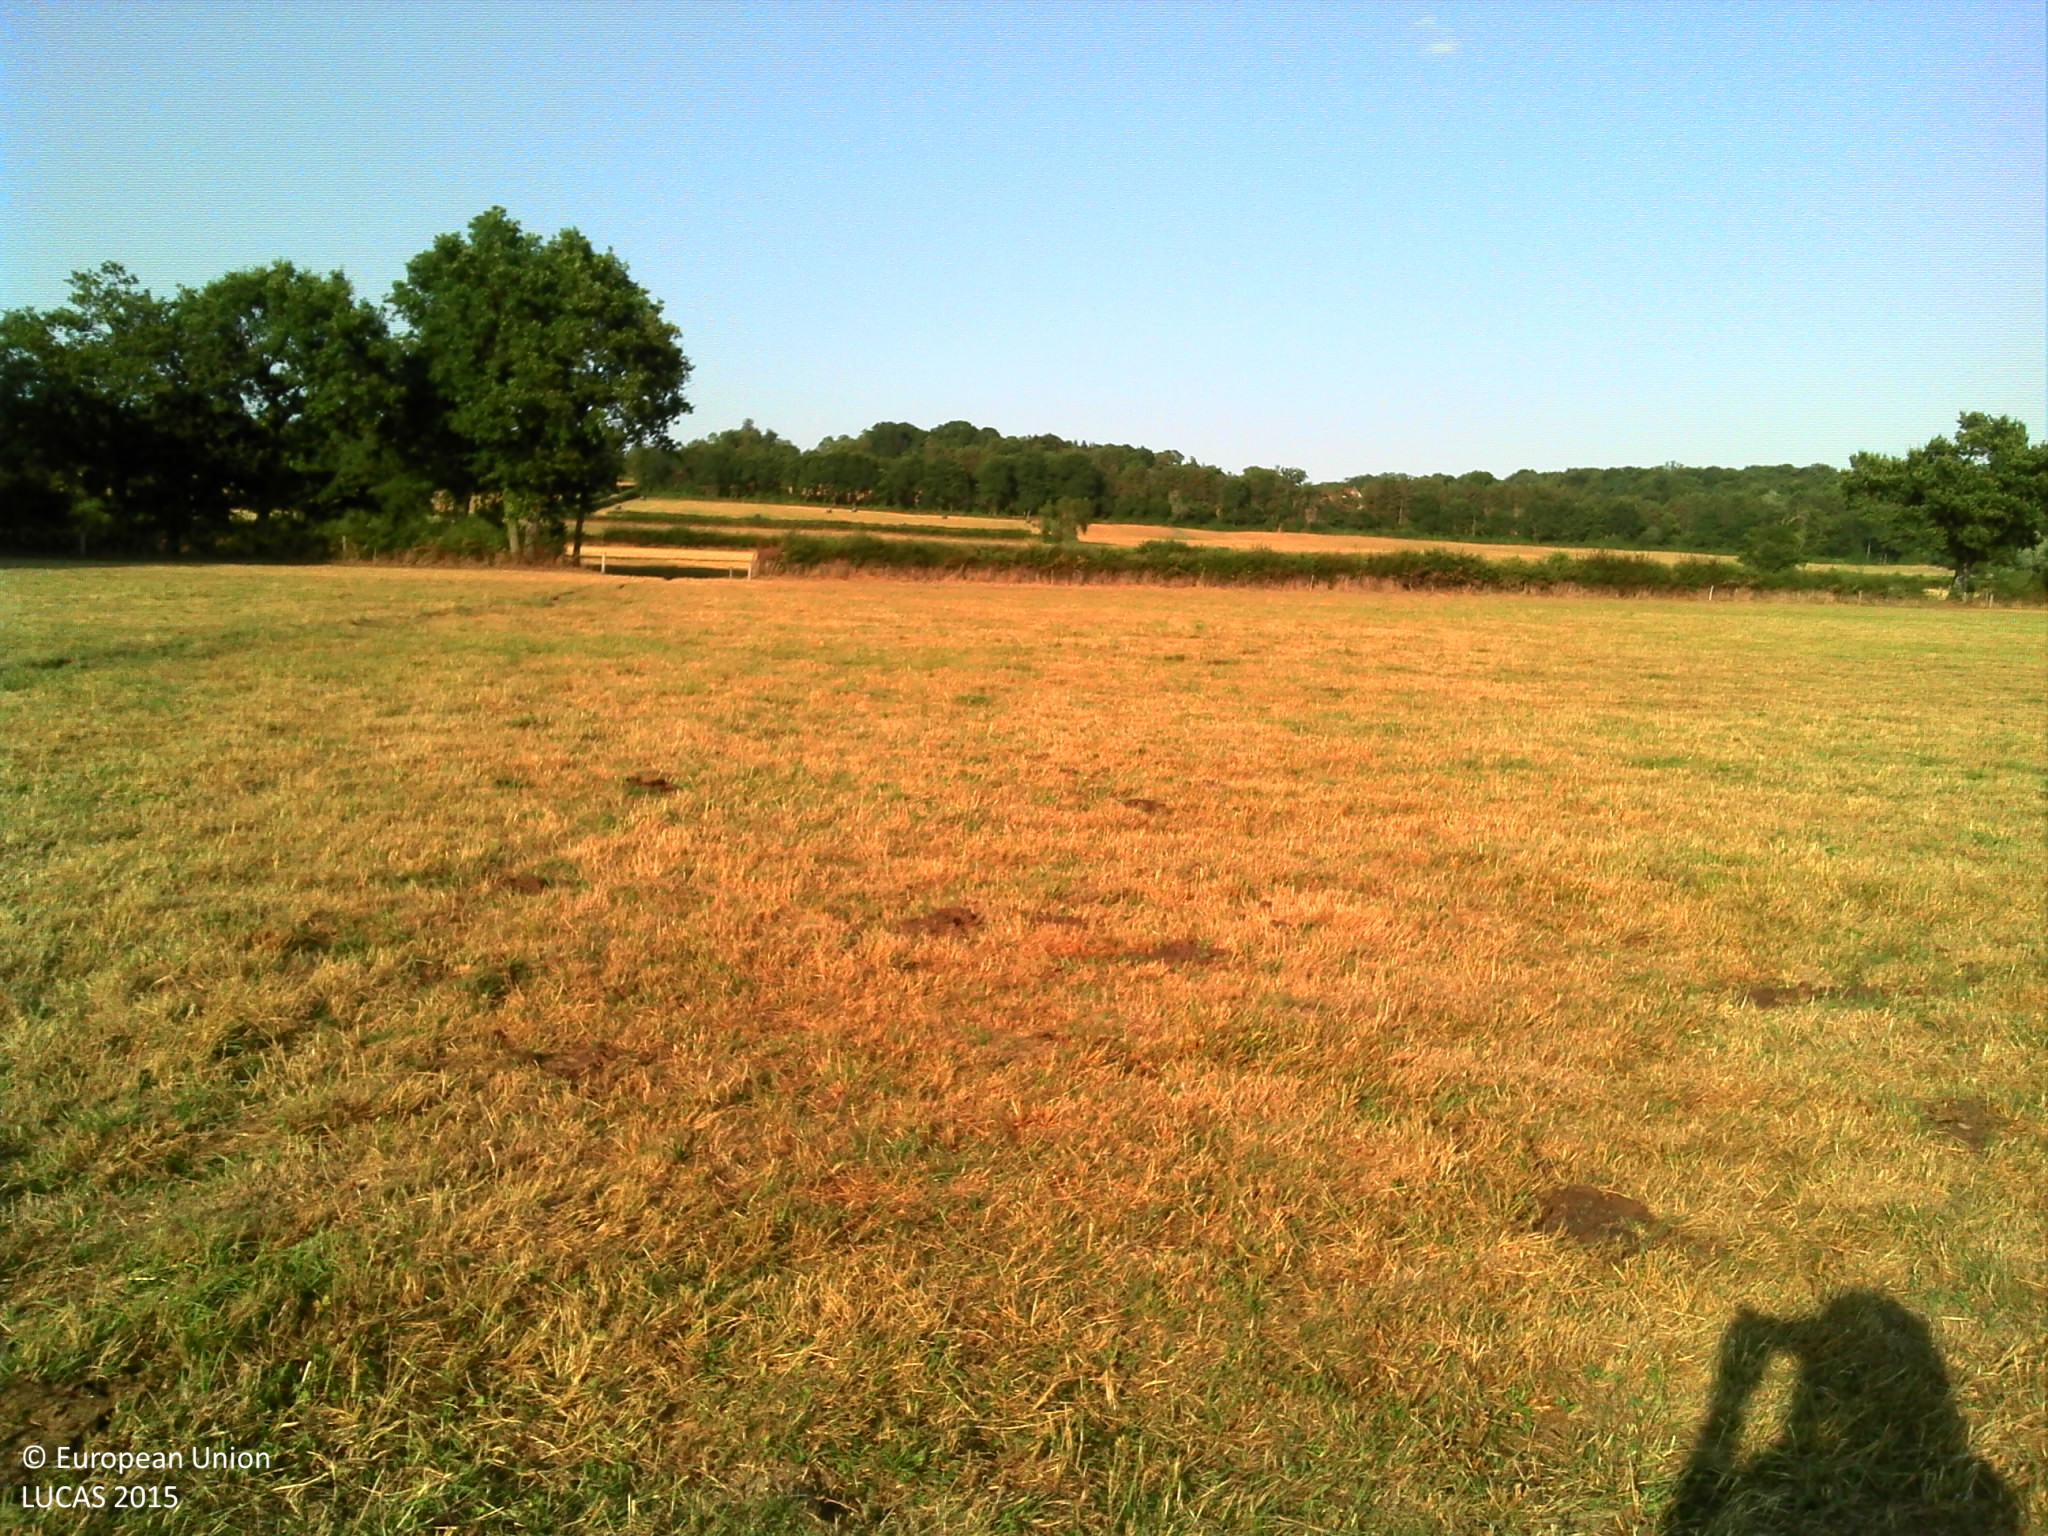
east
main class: Grassland
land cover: Grassland without tree/shrub cover
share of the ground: > 75 %
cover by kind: herbaceous plants 100 %
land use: Agriculture (excluding fallow land and kitchen gardens)
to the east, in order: Grassland without tree/shrub cover; Fences; Managed hedges; Ditches and canals; Fences; Grassland without tree/shrub cover
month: July
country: FR
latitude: 46.7749
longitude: 3.6206
